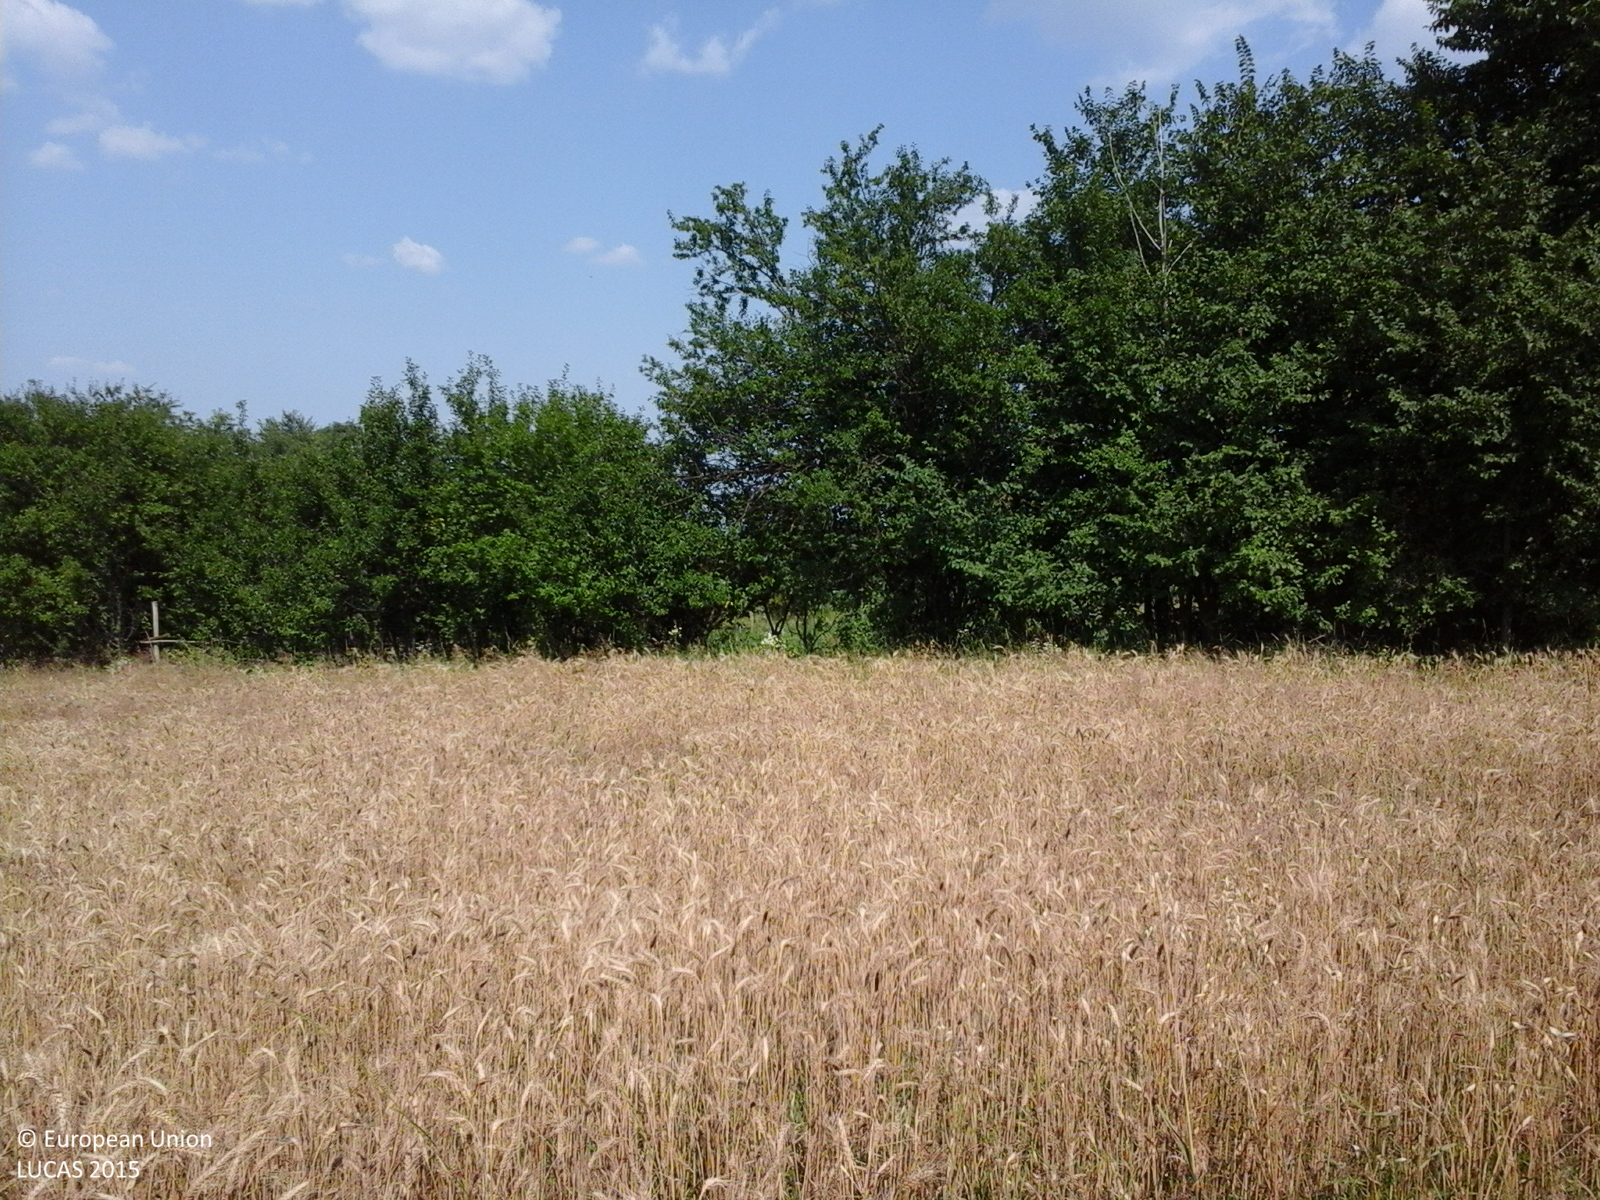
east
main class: Cropland
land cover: Common wheat
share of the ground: > 75 %
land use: Agriculture (excluding fallow land and kitchen gardens)
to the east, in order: Common wheat; Abandoned hedges; Artificial constructions in urban areas; Maize; Fences; Lines of trees; Other fruit trees and berries; Fences; Grassland without tree/shrub cover; Lines of trees; Maize
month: July
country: RO
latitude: 44.7164
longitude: 24.6307
